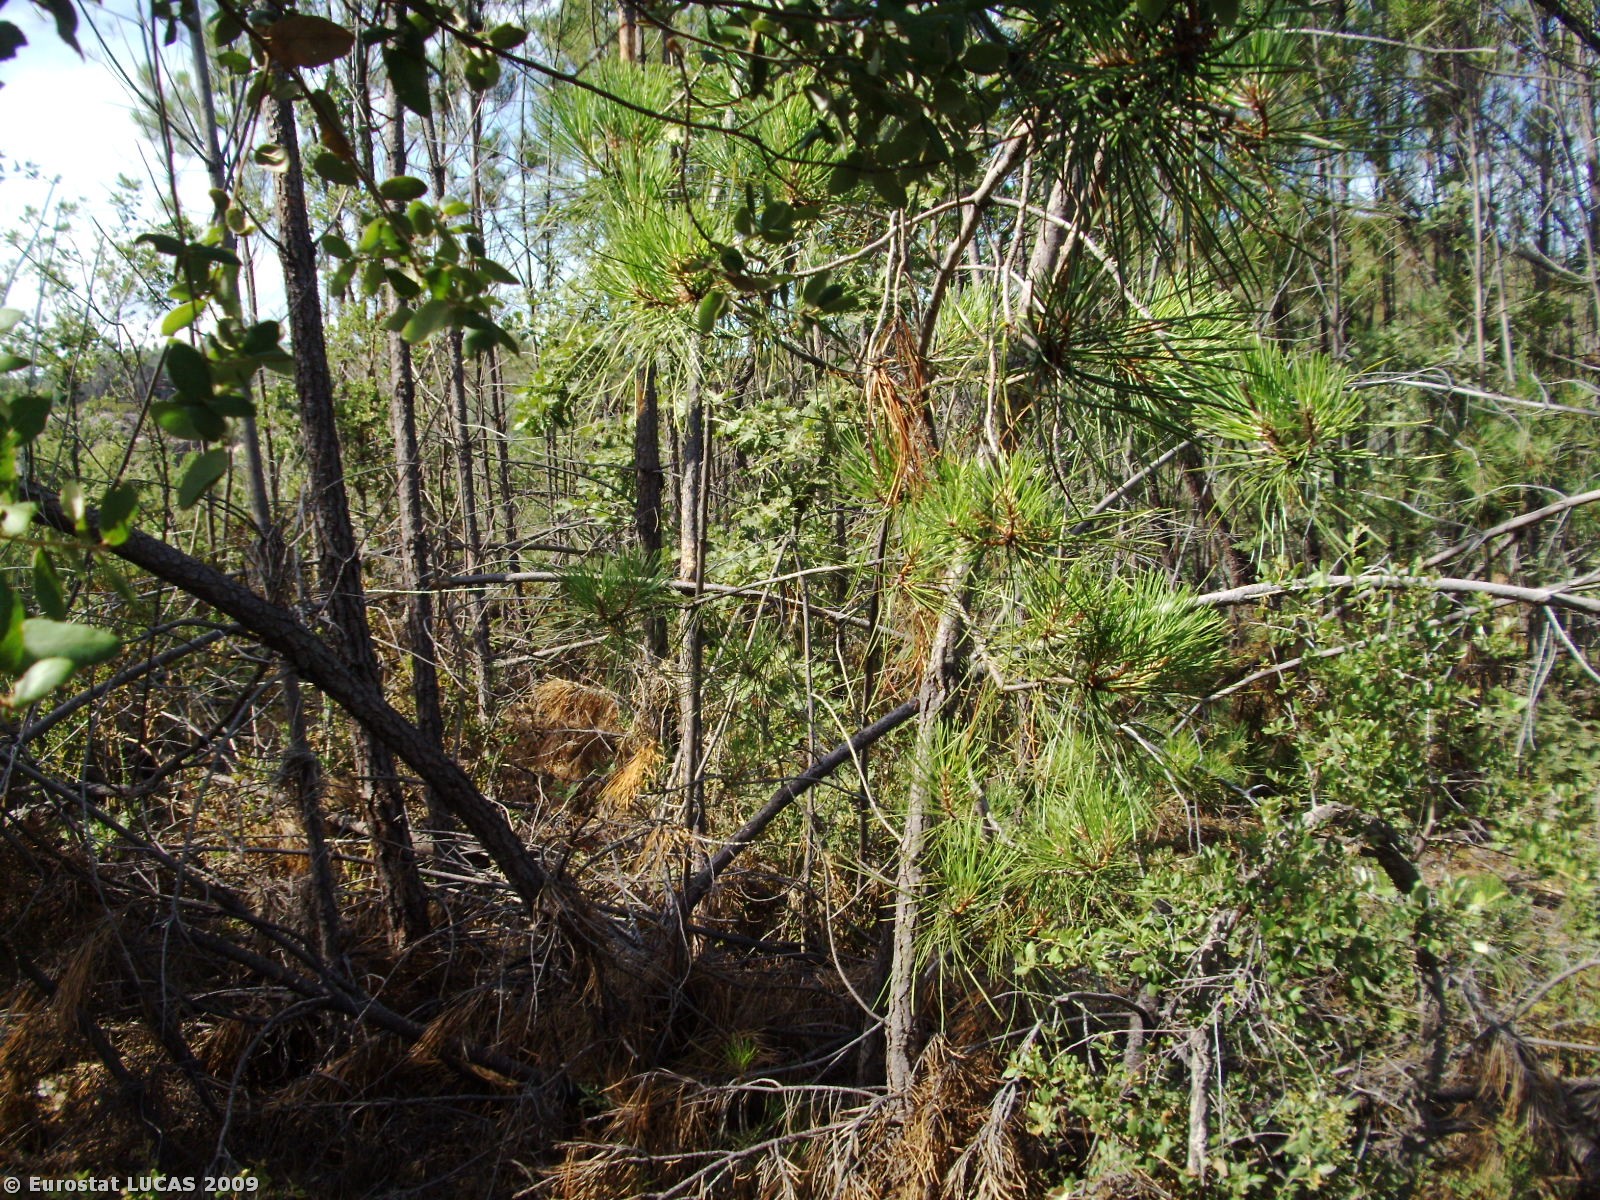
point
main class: Woodland
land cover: Coniferous woodland
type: coniferous forest of the mediterranean region
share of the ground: 25 - 50 %
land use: Forestry
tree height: > 5 m
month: July
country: PT
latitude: 40.2484
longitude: -7.3008
